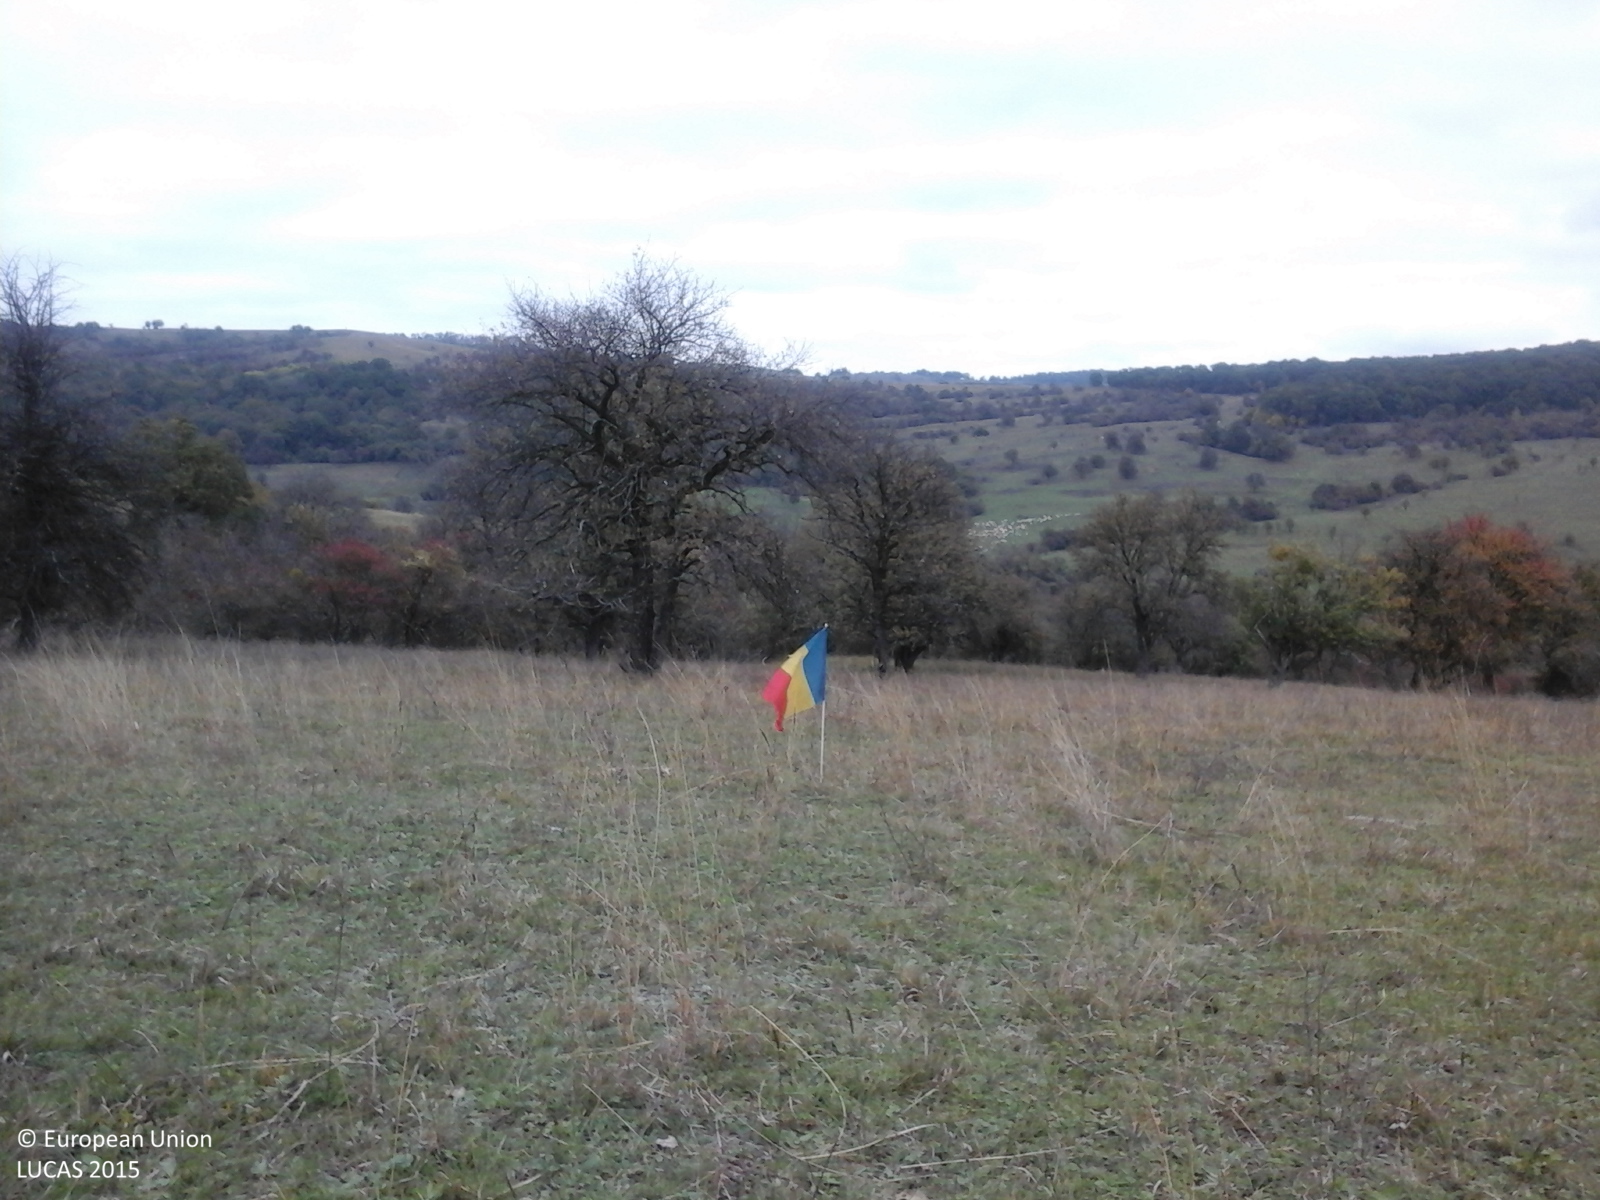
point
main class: Grassland
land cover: Grassland with sparse tree/shrub cover
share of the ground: > 75 %
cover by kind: herbaceous plants 95 %, broadleaved forest trees 5 %
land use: Agriculture (excluding fallow land and kitchen gardens)
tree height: > 5 m
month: October
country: RO
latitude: 45.9501
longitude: 24.8355
